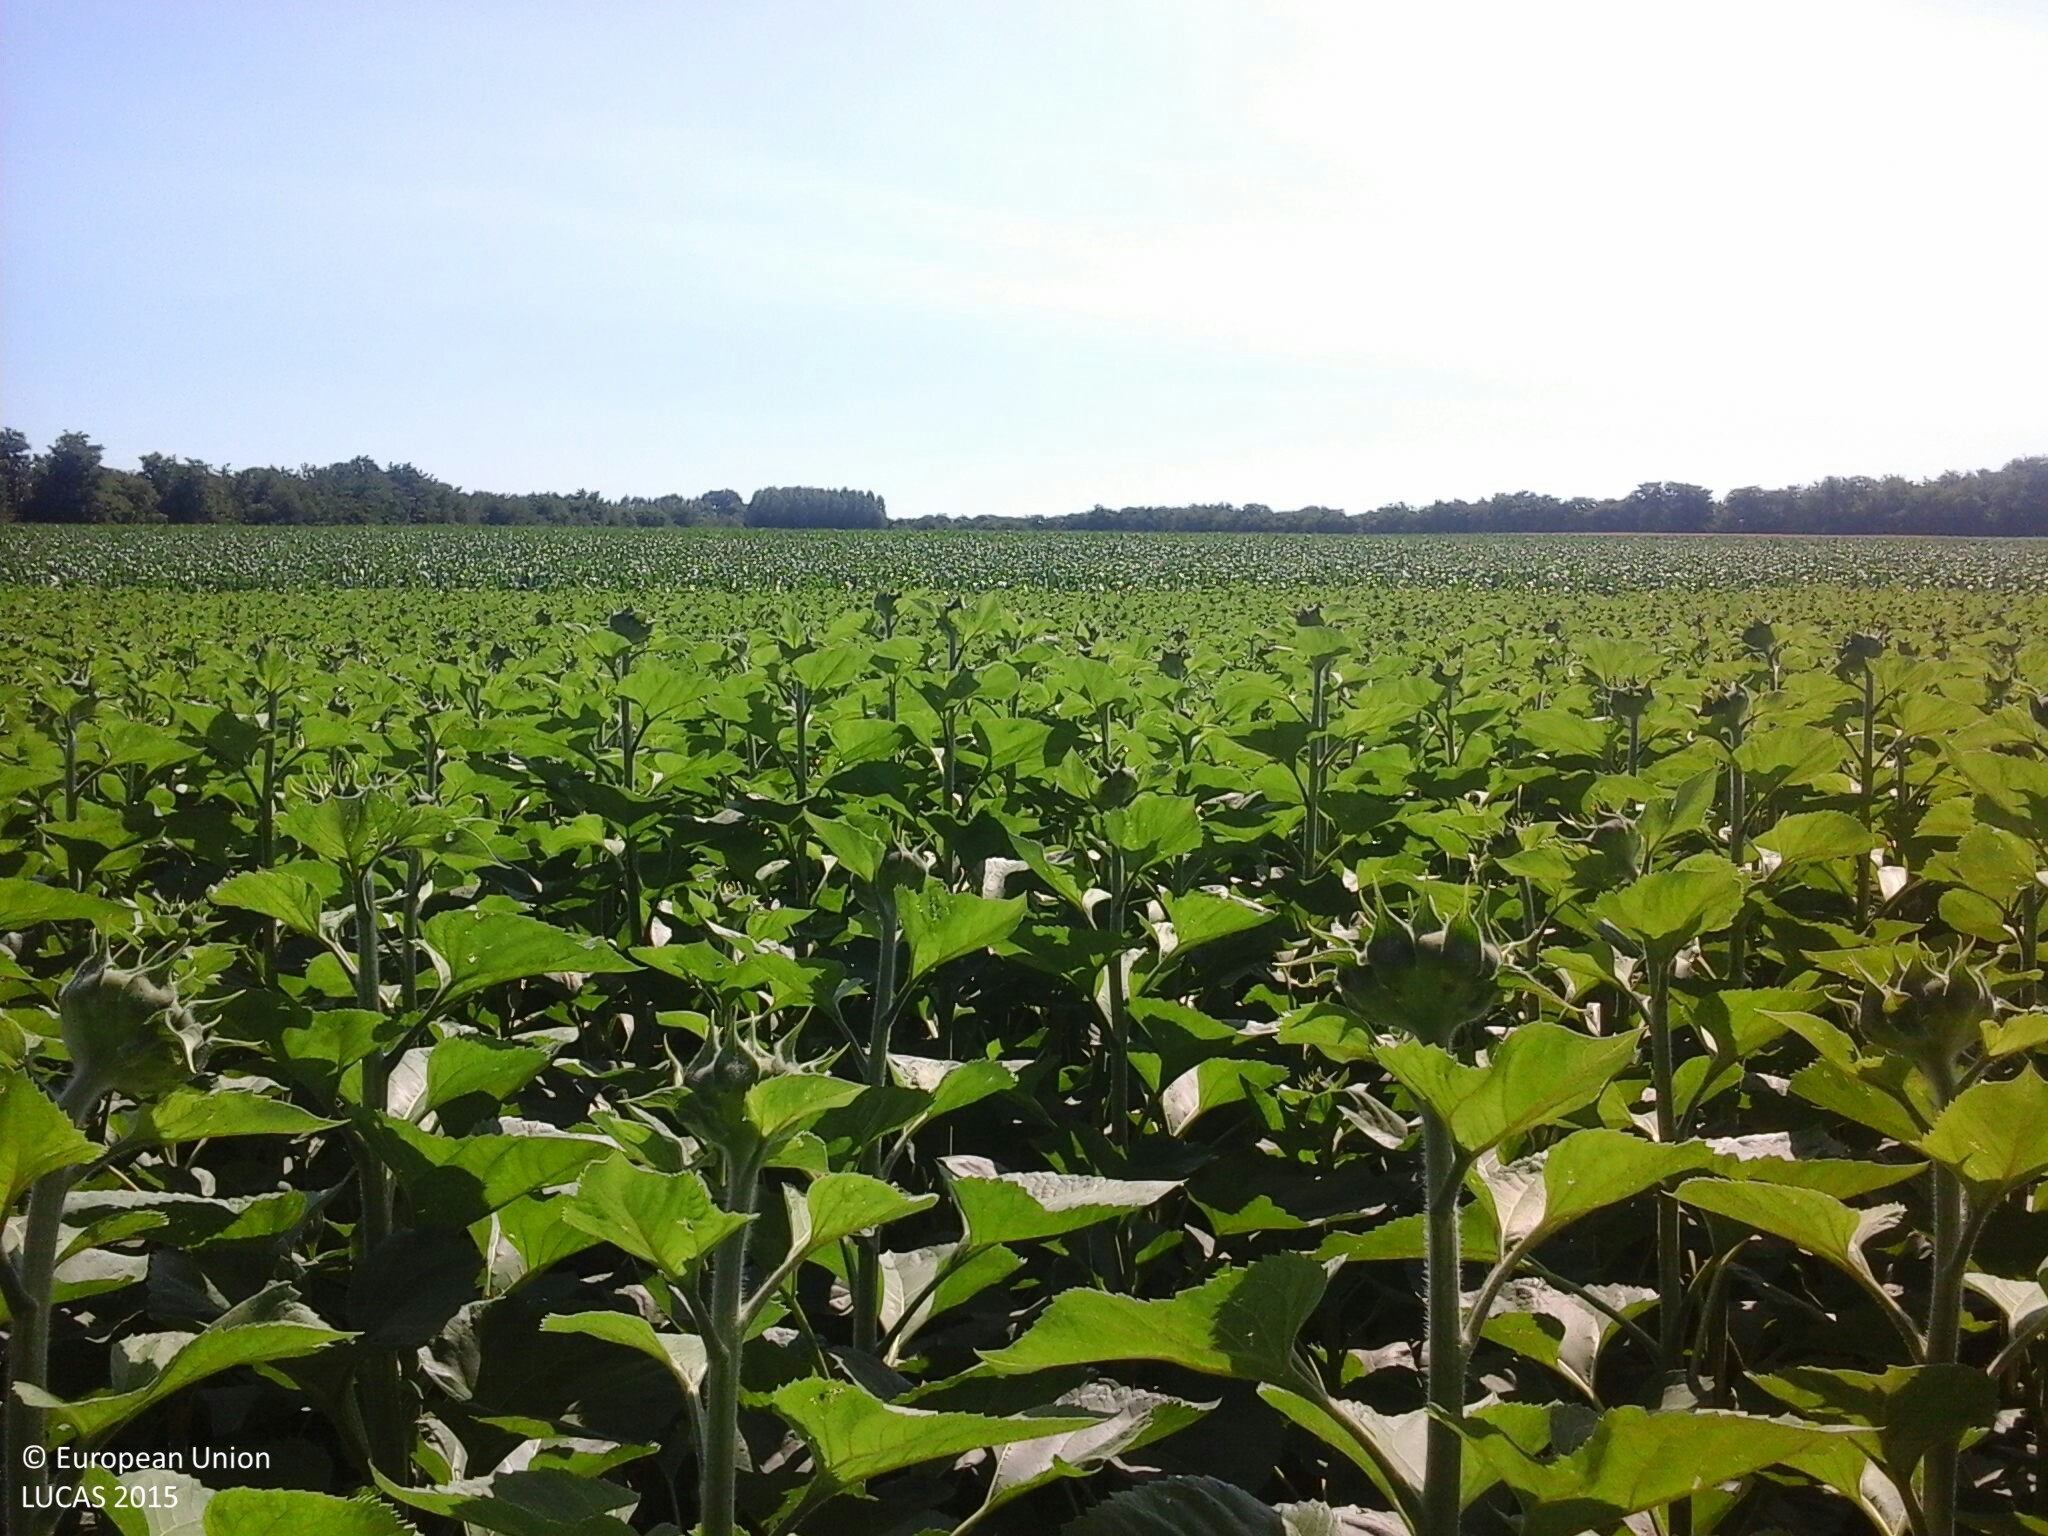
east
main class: Cropland
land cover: Sunflower
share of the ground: > 75 %
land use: Agriculture (excluding fallow land and kitchen gardens)
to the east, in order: Sunflower; Maize
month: July
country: HU
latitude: 47.8603
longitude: 21.7978
